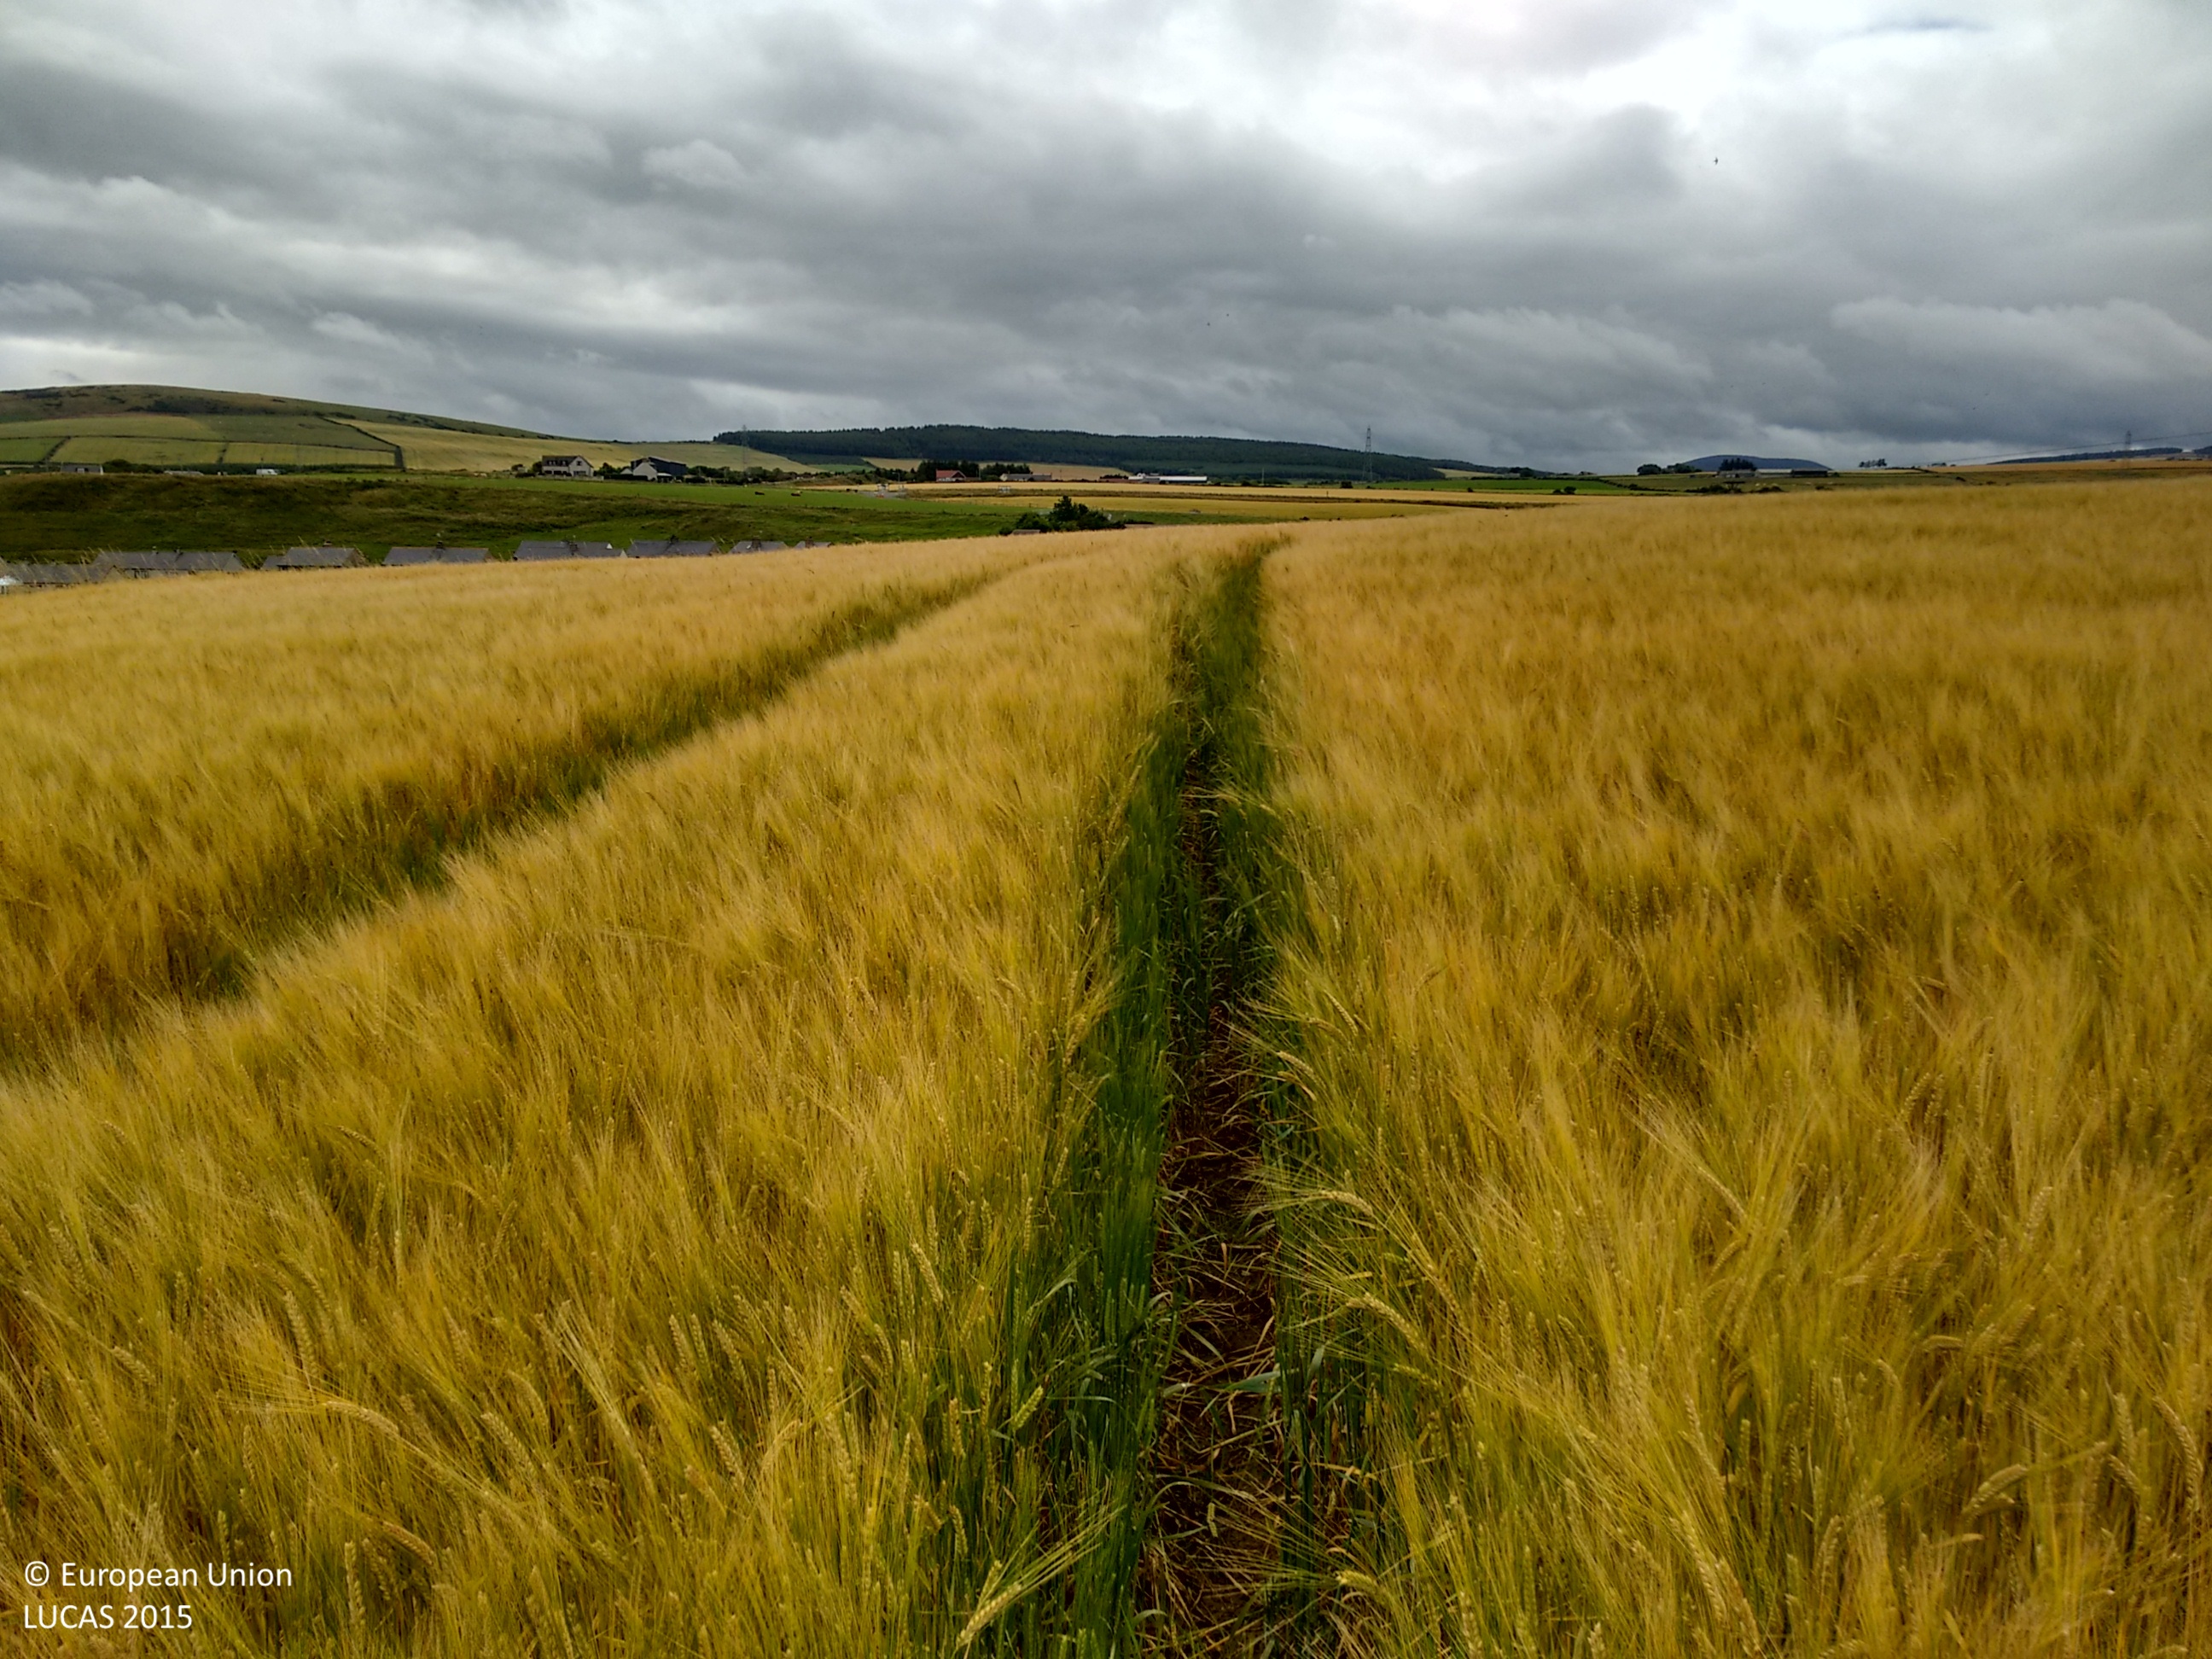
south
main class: Cropland
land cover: Barley
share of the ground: > 75 %
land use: Agriculture (excluding fallow land and kitchen gardens)
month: August
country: GB
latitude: 57.6819
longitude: -2.7514
